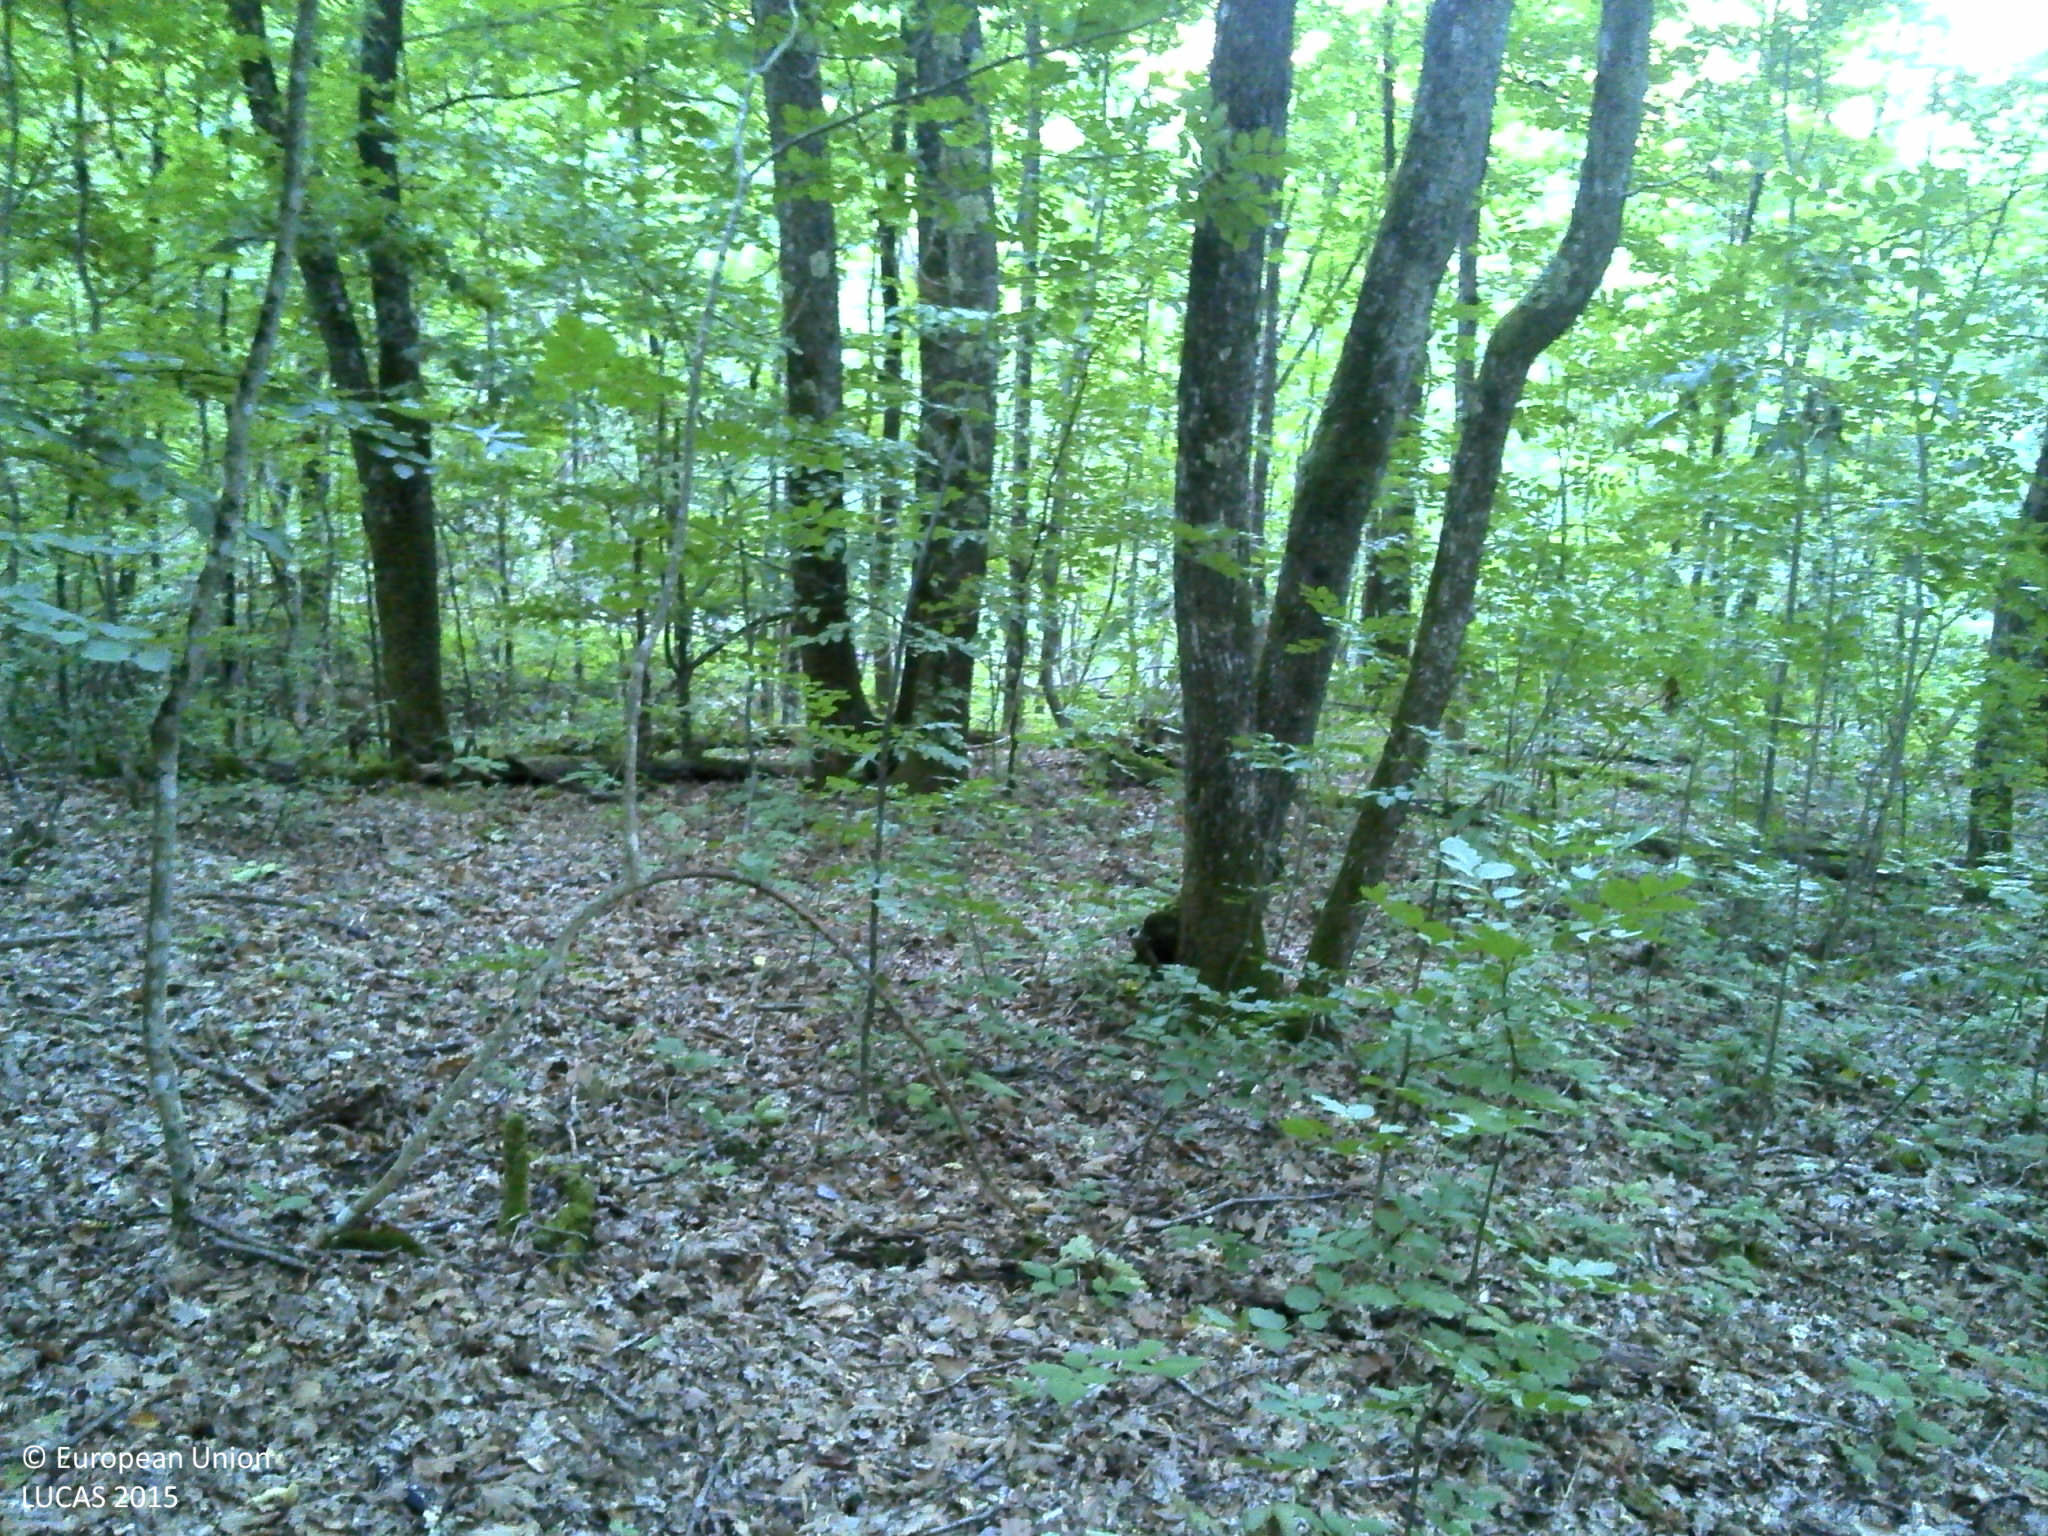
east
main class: Woodland
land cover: Broadleaved woodland
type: acidophilous oak and oak-birch forest
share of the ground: > 75 %
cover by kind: broadleaved forest trees 100 %
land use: Forestry
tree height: > 5 m
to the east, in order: Broadleaved woodland; Spontaneously vegetated surfaces
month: August
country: HR
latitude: 45.1555
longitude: 16.2676
